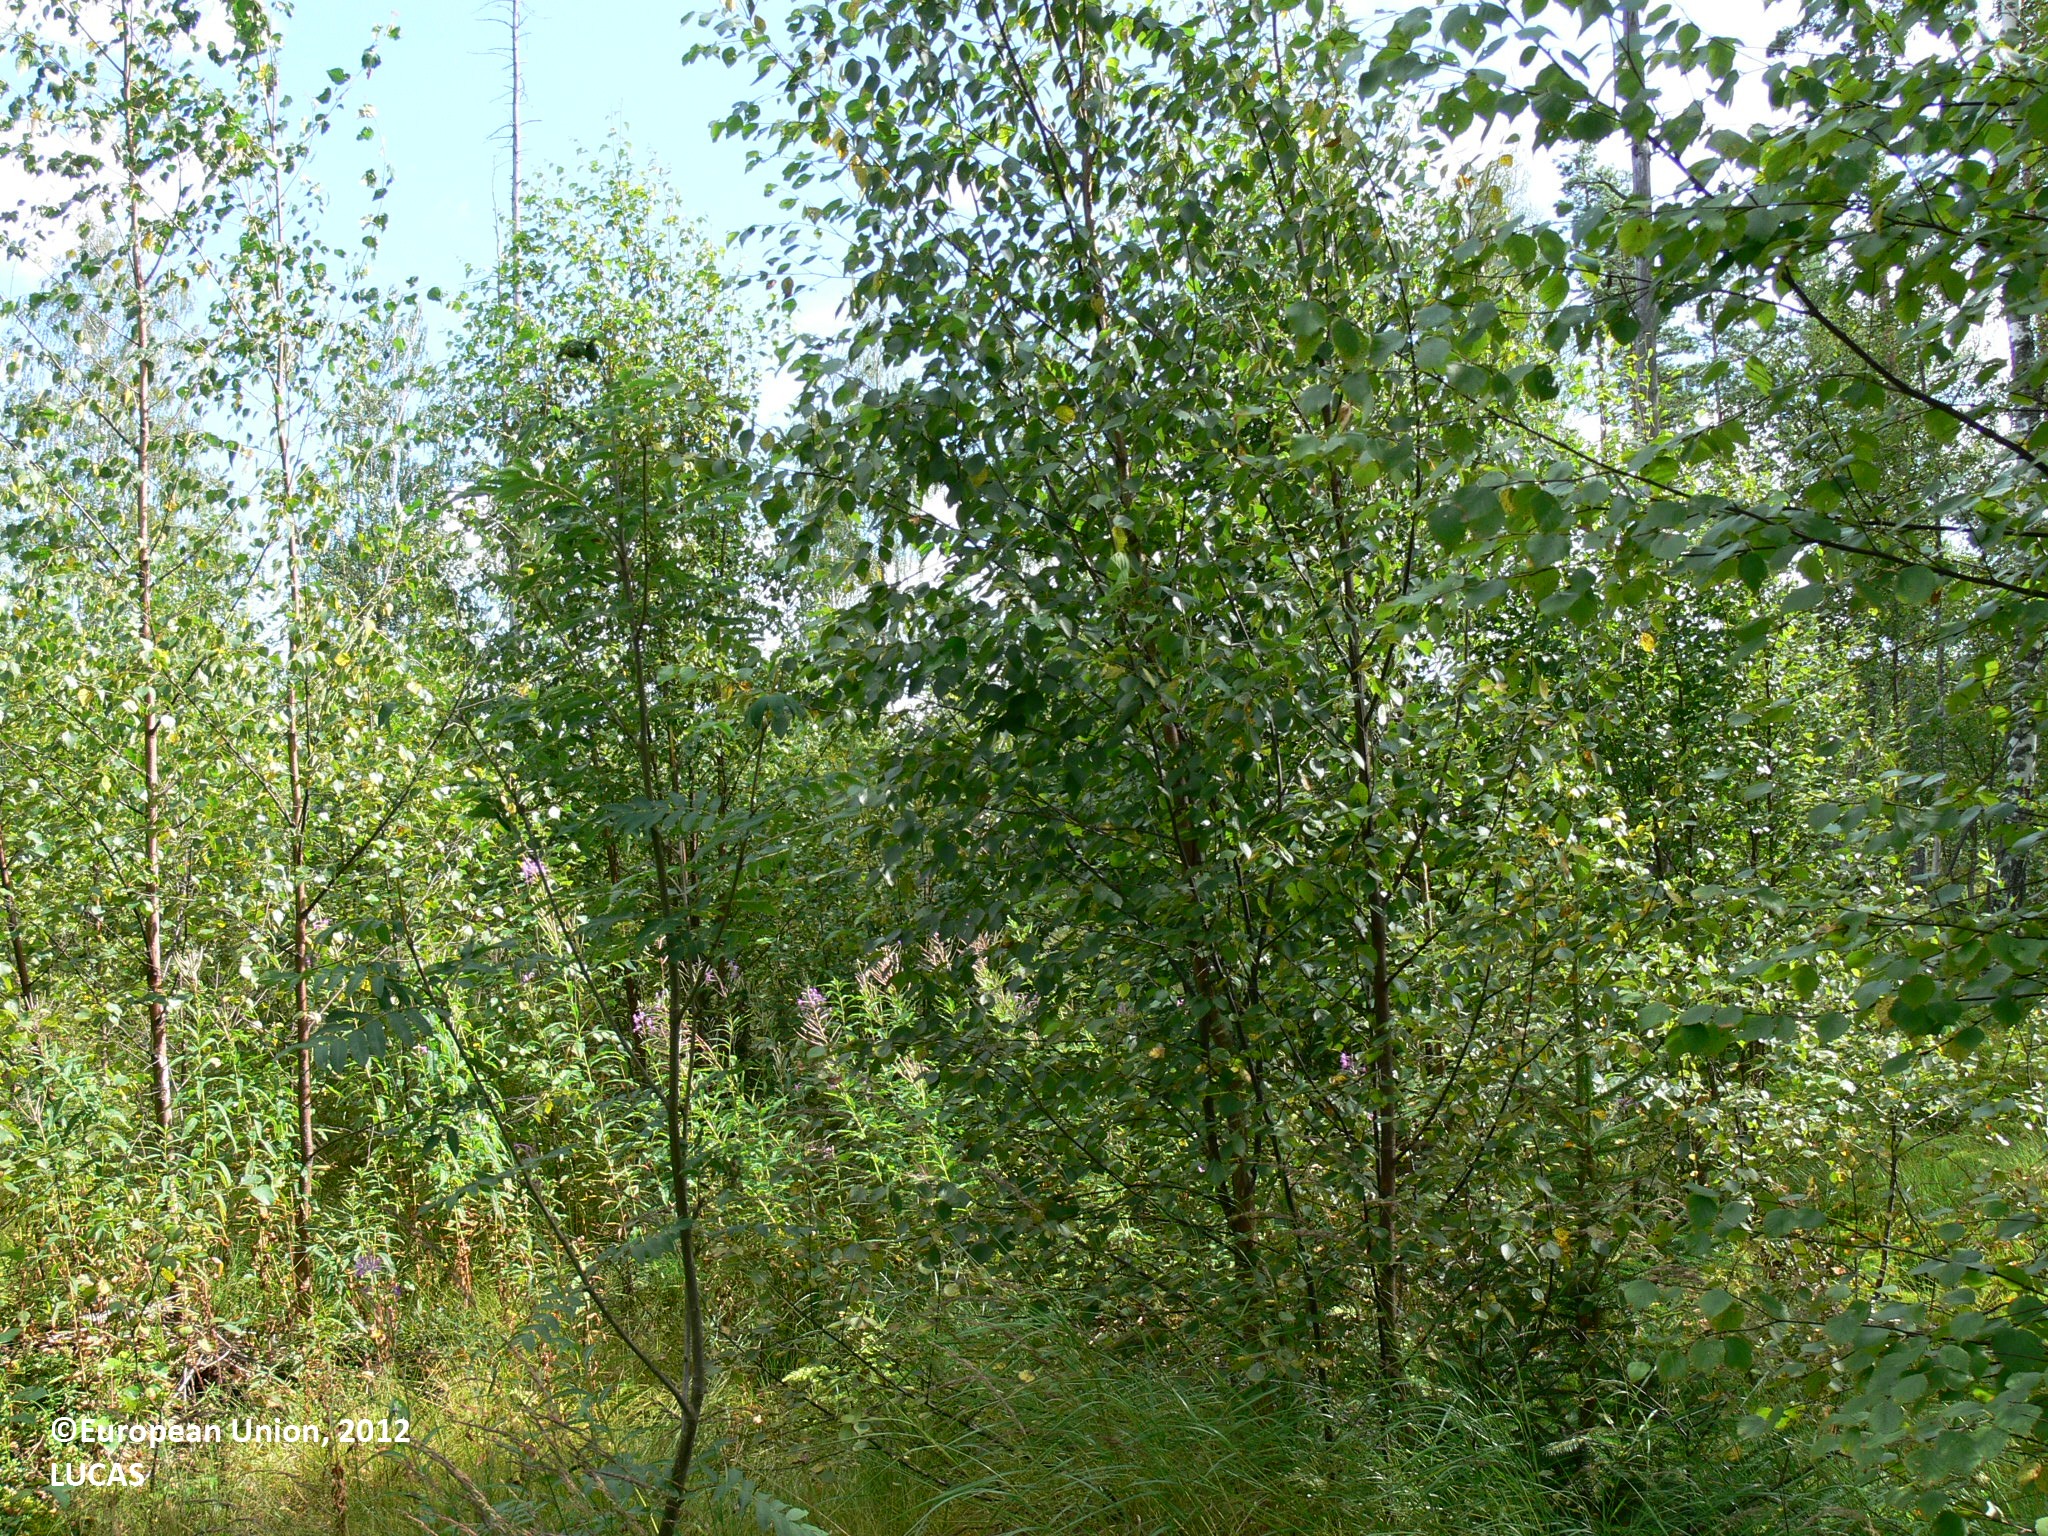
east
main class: Woodland
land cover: Broadleaved woodland
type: boreal forest
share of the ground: 50 - 75 %
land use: Forestry
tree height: < 5 m
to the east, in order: Broadleaved woodland; Pine dominated mixed woodland; Inland water bodies
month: August
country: FI
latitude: 61.8871
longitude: 29.2800
